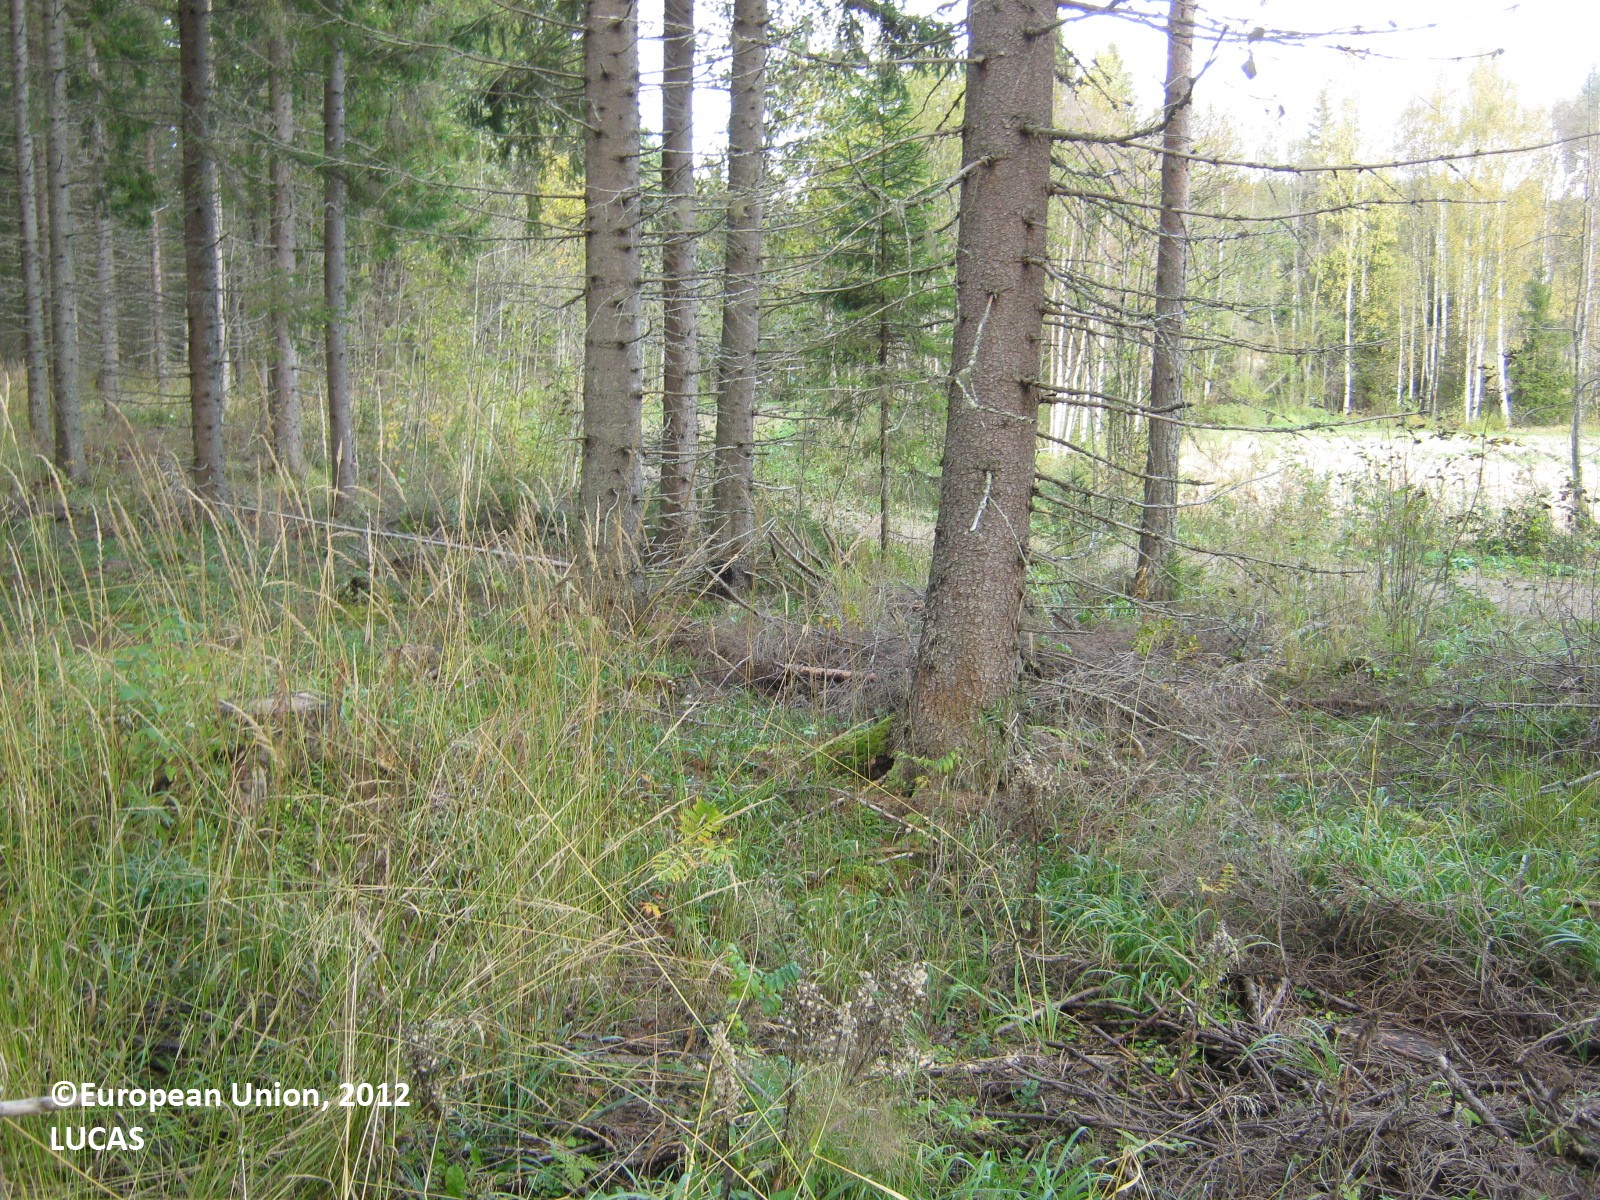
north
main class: Woodland
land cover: Spruce dominated coniferous woodland
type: boreal forest
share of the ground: 25 - 50 %
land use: Forestry
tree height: > 5 m
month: September
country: FI
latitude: 62.6094
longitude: 27.8493
